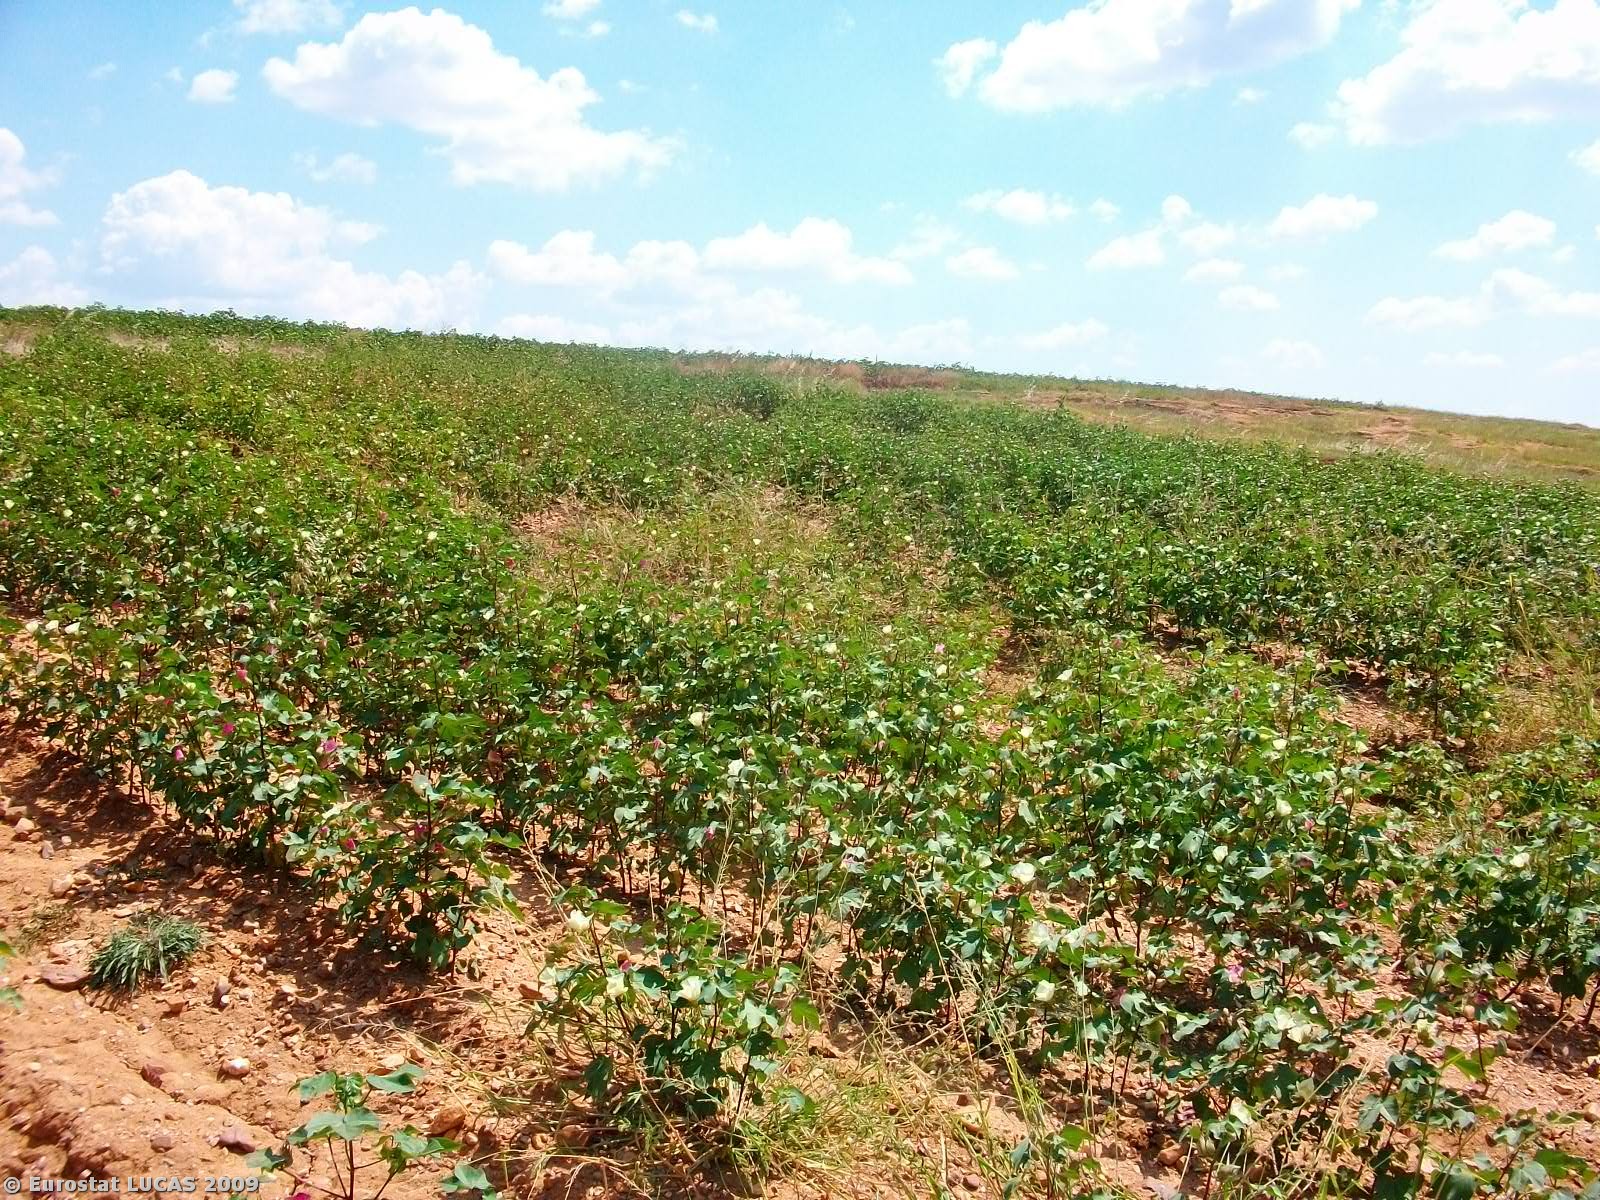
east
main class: Cropland
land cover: Cotton
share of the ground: 25 - 50 %
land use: Agriculture (excluding fallow land and kitchen gardens)
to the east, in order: Cotton; Grass margins; Tracks; Grass margins; Vineyards; Bare land; Grass margins; Cotton; Grass margins; Tracks; Grass margins; Bare land
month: August
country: GR
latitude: 41.4687
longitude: 26.4206
